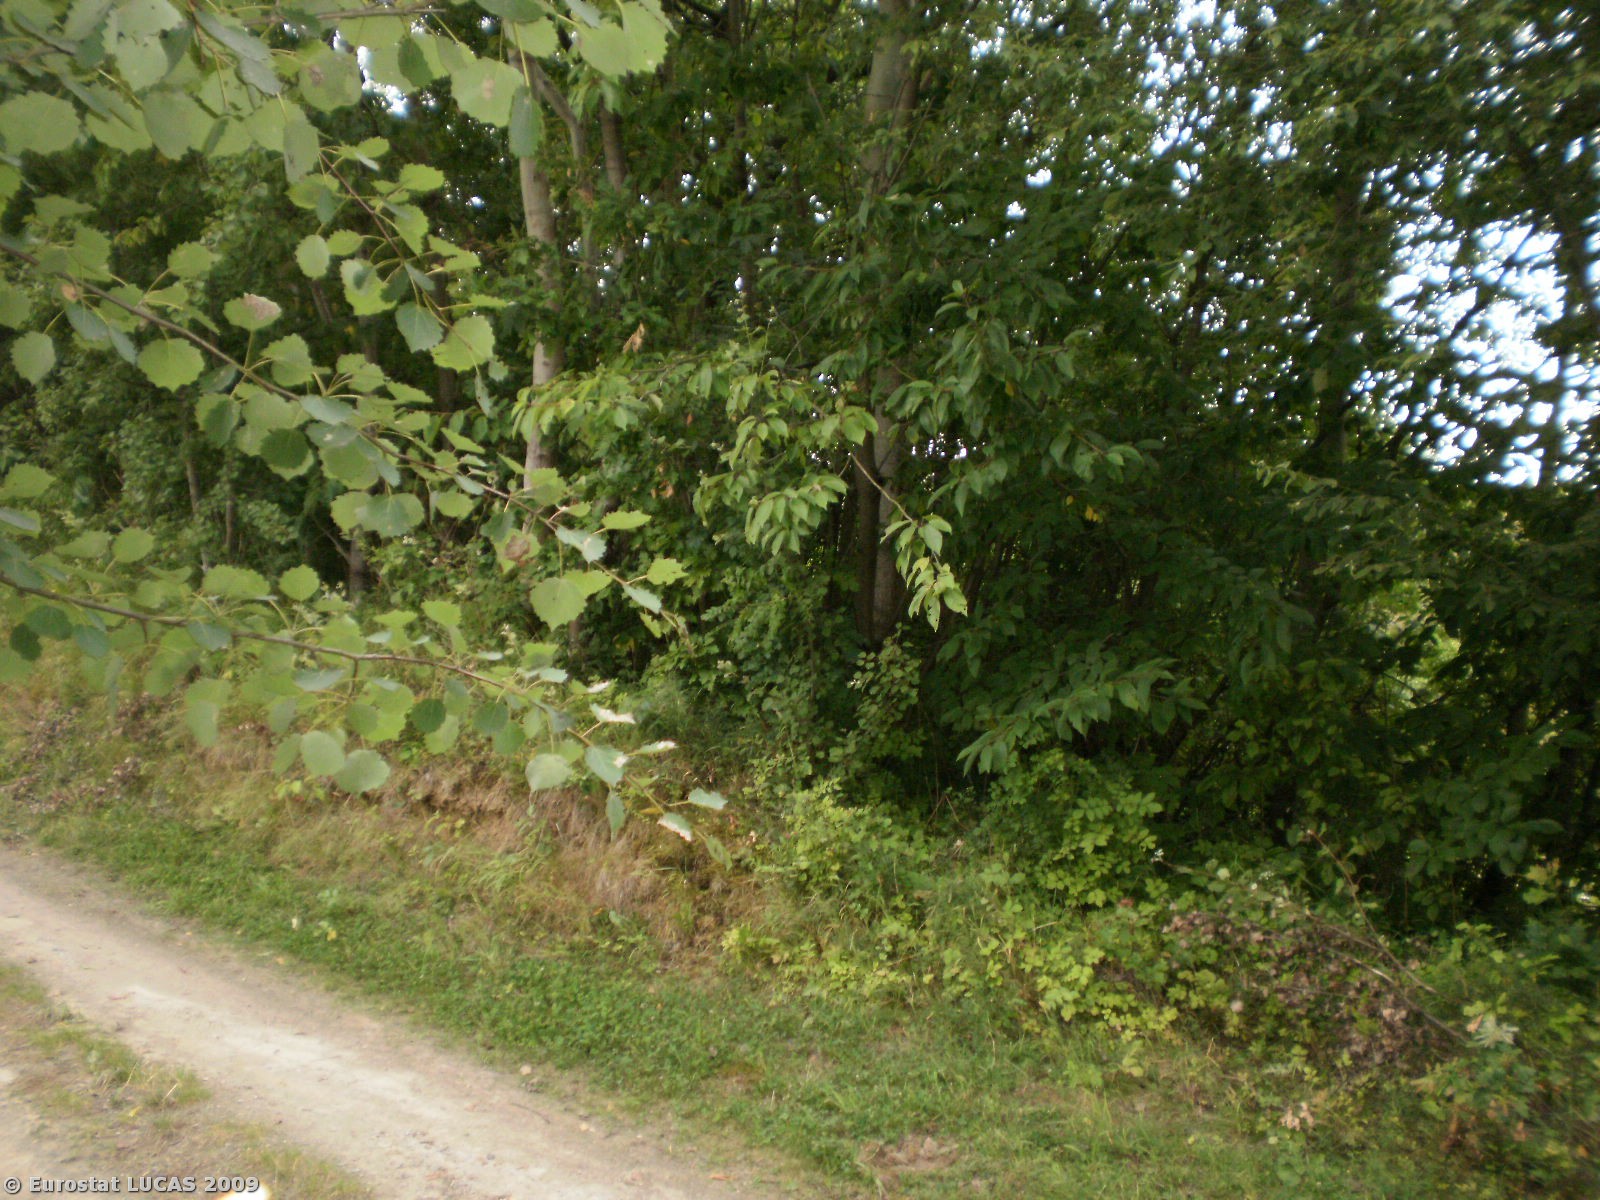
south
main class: Grassland
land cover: Grassland without tree/shrub cover
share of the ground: > 75 %
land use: Agriculture (excluding fallow land and kitchen gardens)
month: July
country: BE
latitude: 50.9202
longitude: 4.2052
